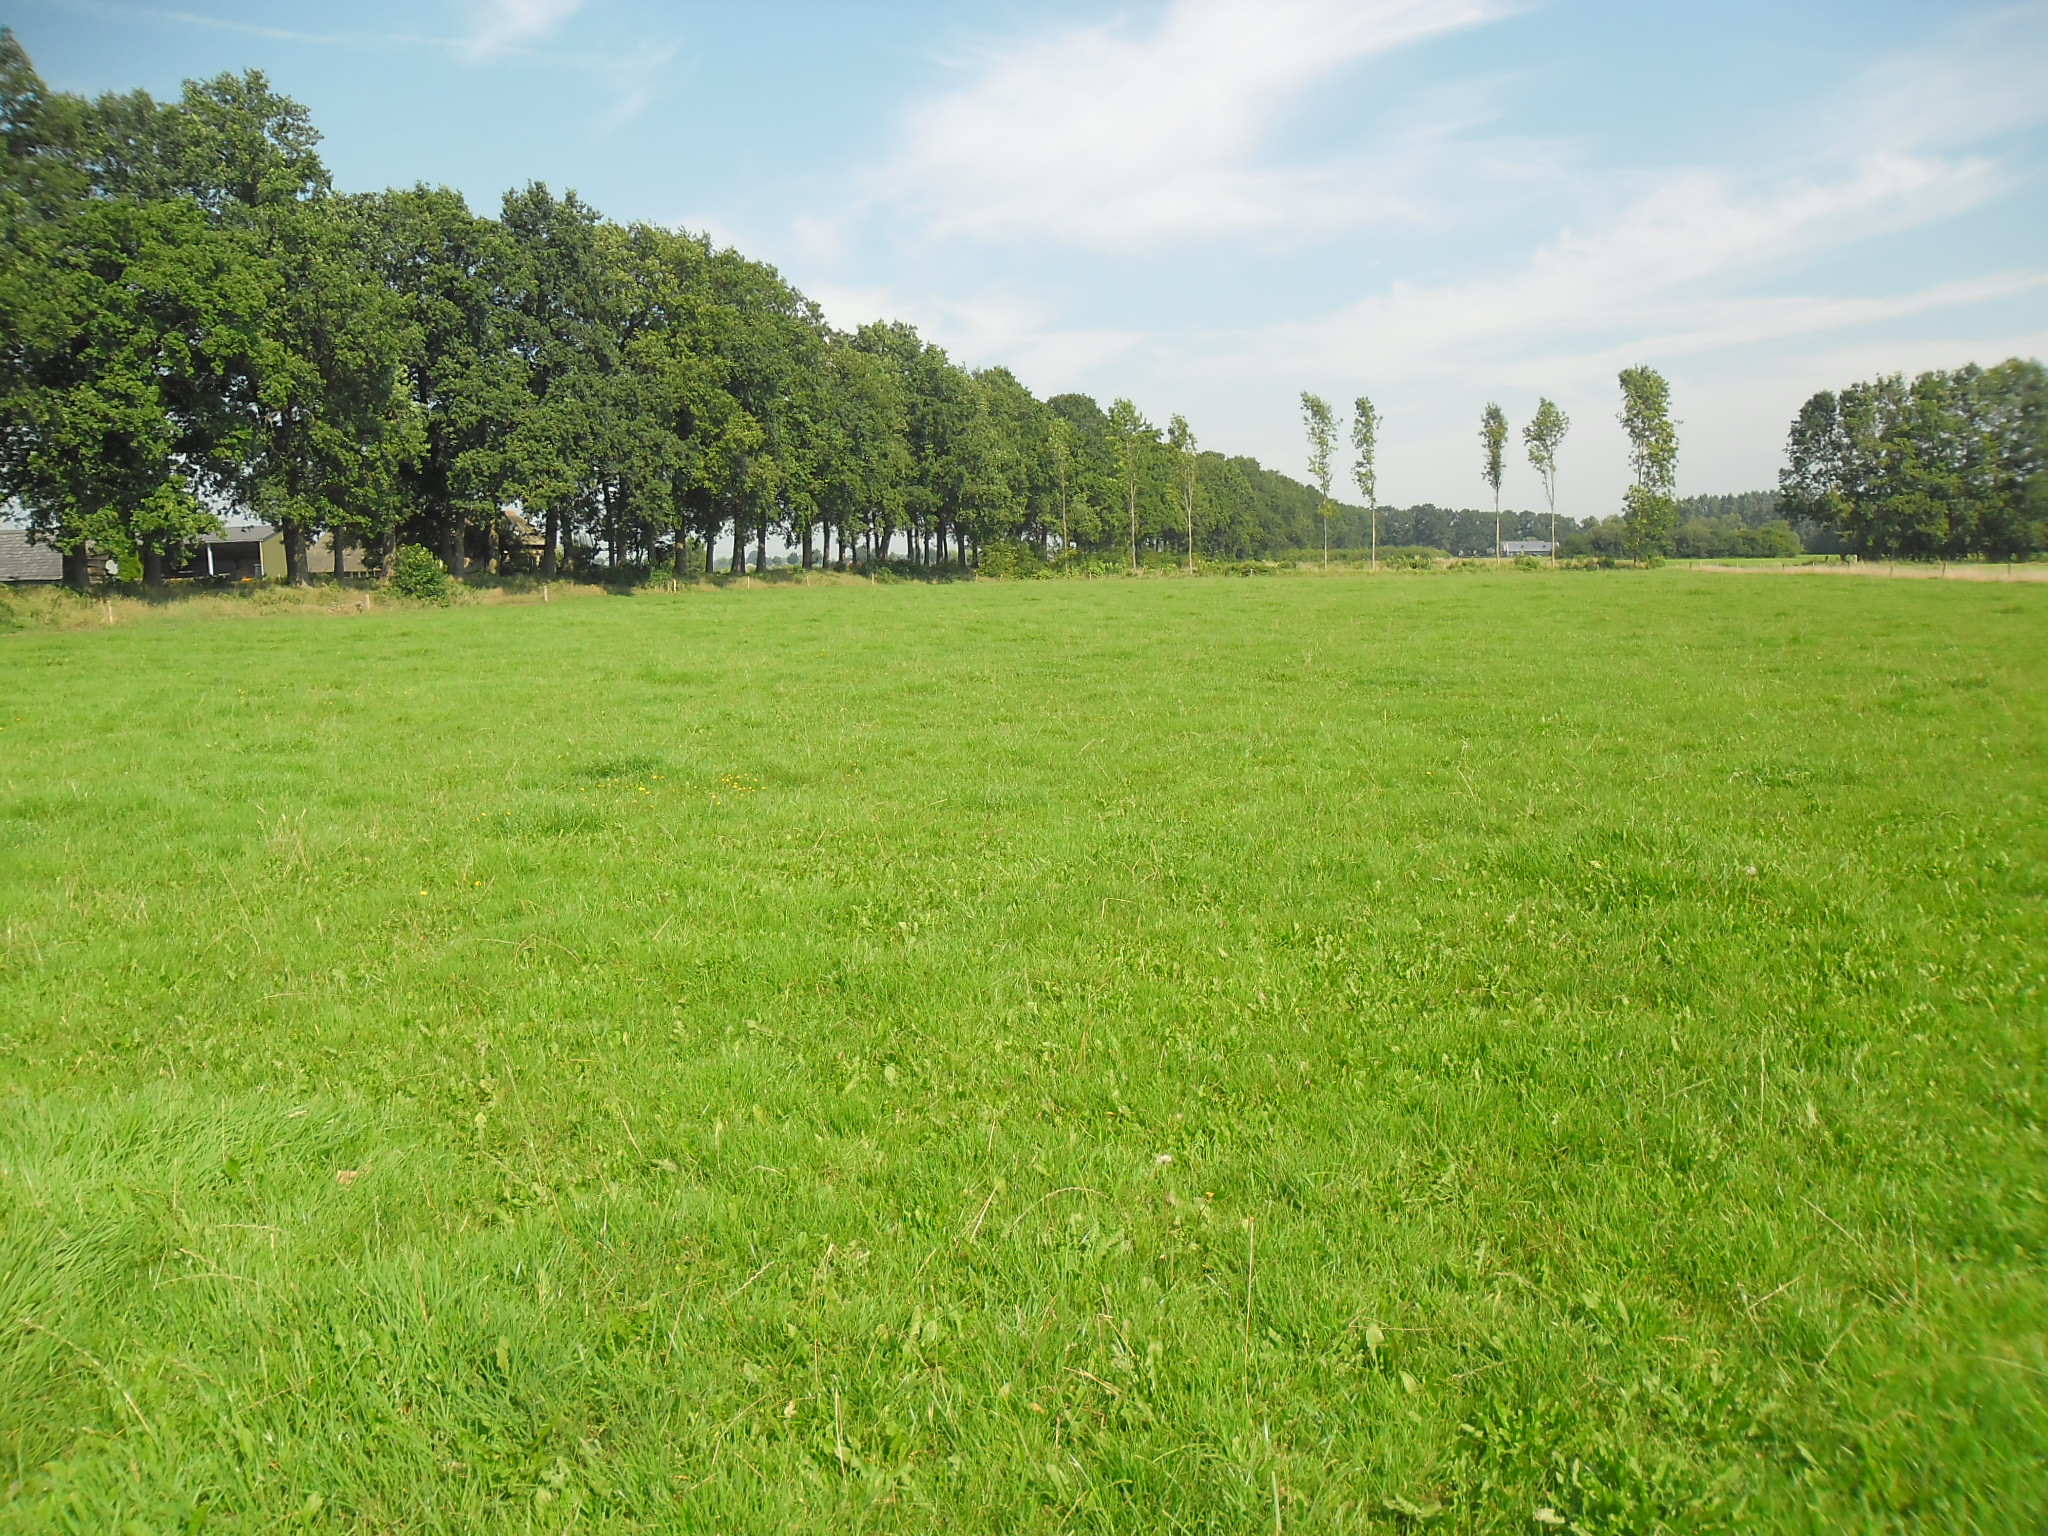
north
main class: Grassland
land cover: Grassland without tree/shrub cover
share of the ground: > 75 %
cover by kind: herbaceous plants 100 %
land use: Agriculture (excluding fallow land and kitchen gardens)
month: August
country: NL
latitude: 52.4603
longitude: 6.1876
